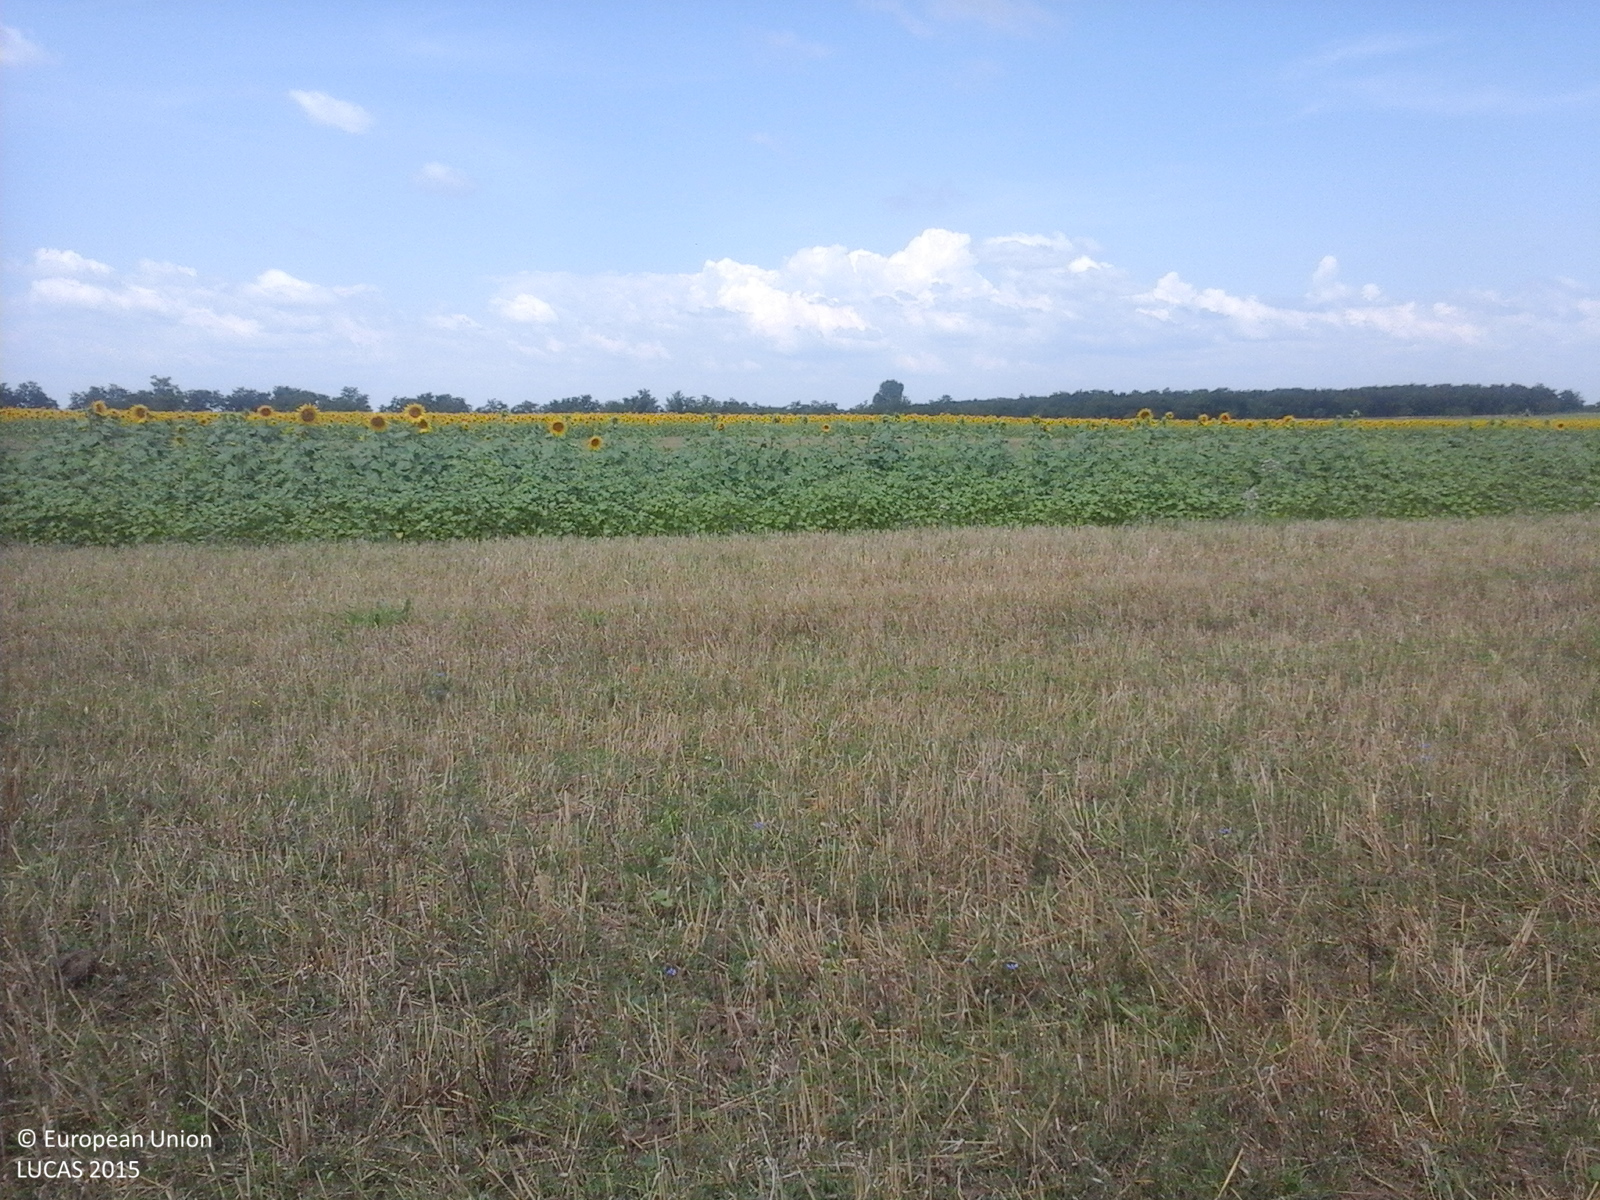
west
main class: Cropland
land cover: Common wheat
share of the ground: > 75 %
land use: Agriculture (excluding fallow land and kitchen gardens)
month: July
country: RO
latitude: 43.9319
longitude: 24.2240
